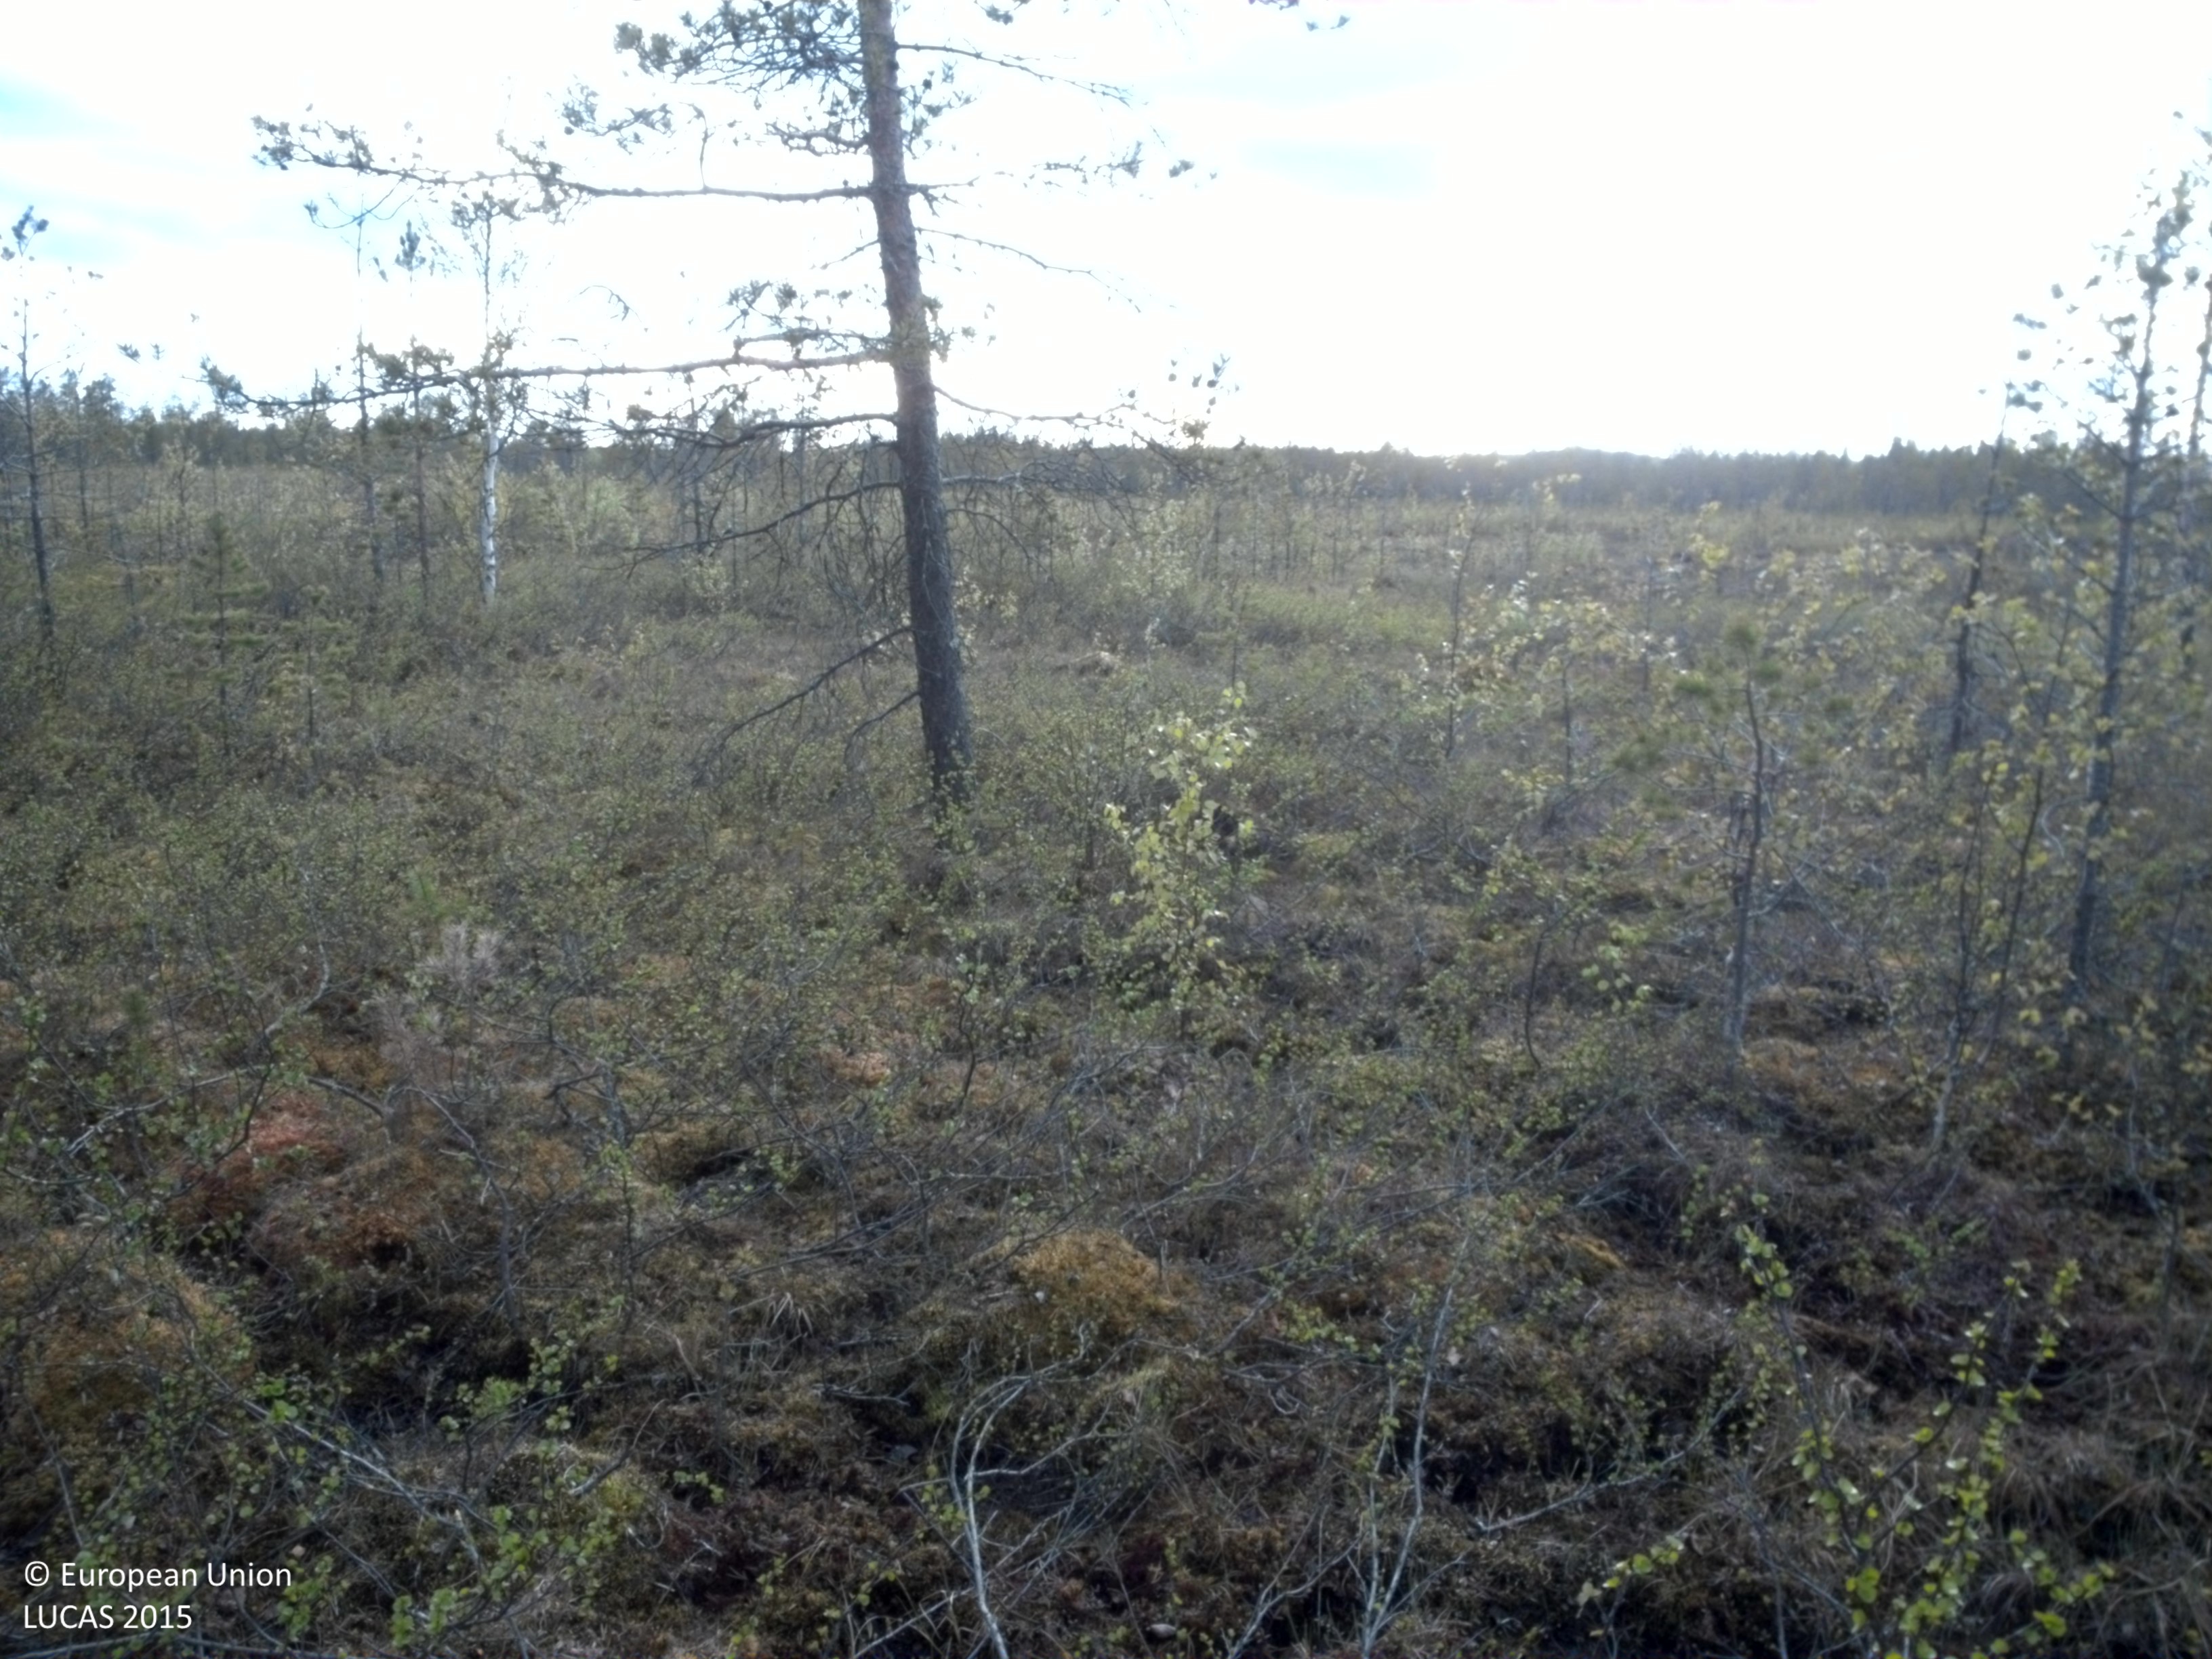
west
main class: Woodland
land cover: Pine dominated mixed woodland
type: boreal forest
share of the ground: 10 - 25 %
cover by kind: shrubs 65 %, coniferous forest trees 15 %, lichens and mosses 10 %, broadleaved forest trees 5 %, herbaceous plants 5 %
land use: Semi-natural and natural areas not in use
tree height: > 5 m
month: June
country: SE
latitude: 66.9152
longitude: 21.6833
